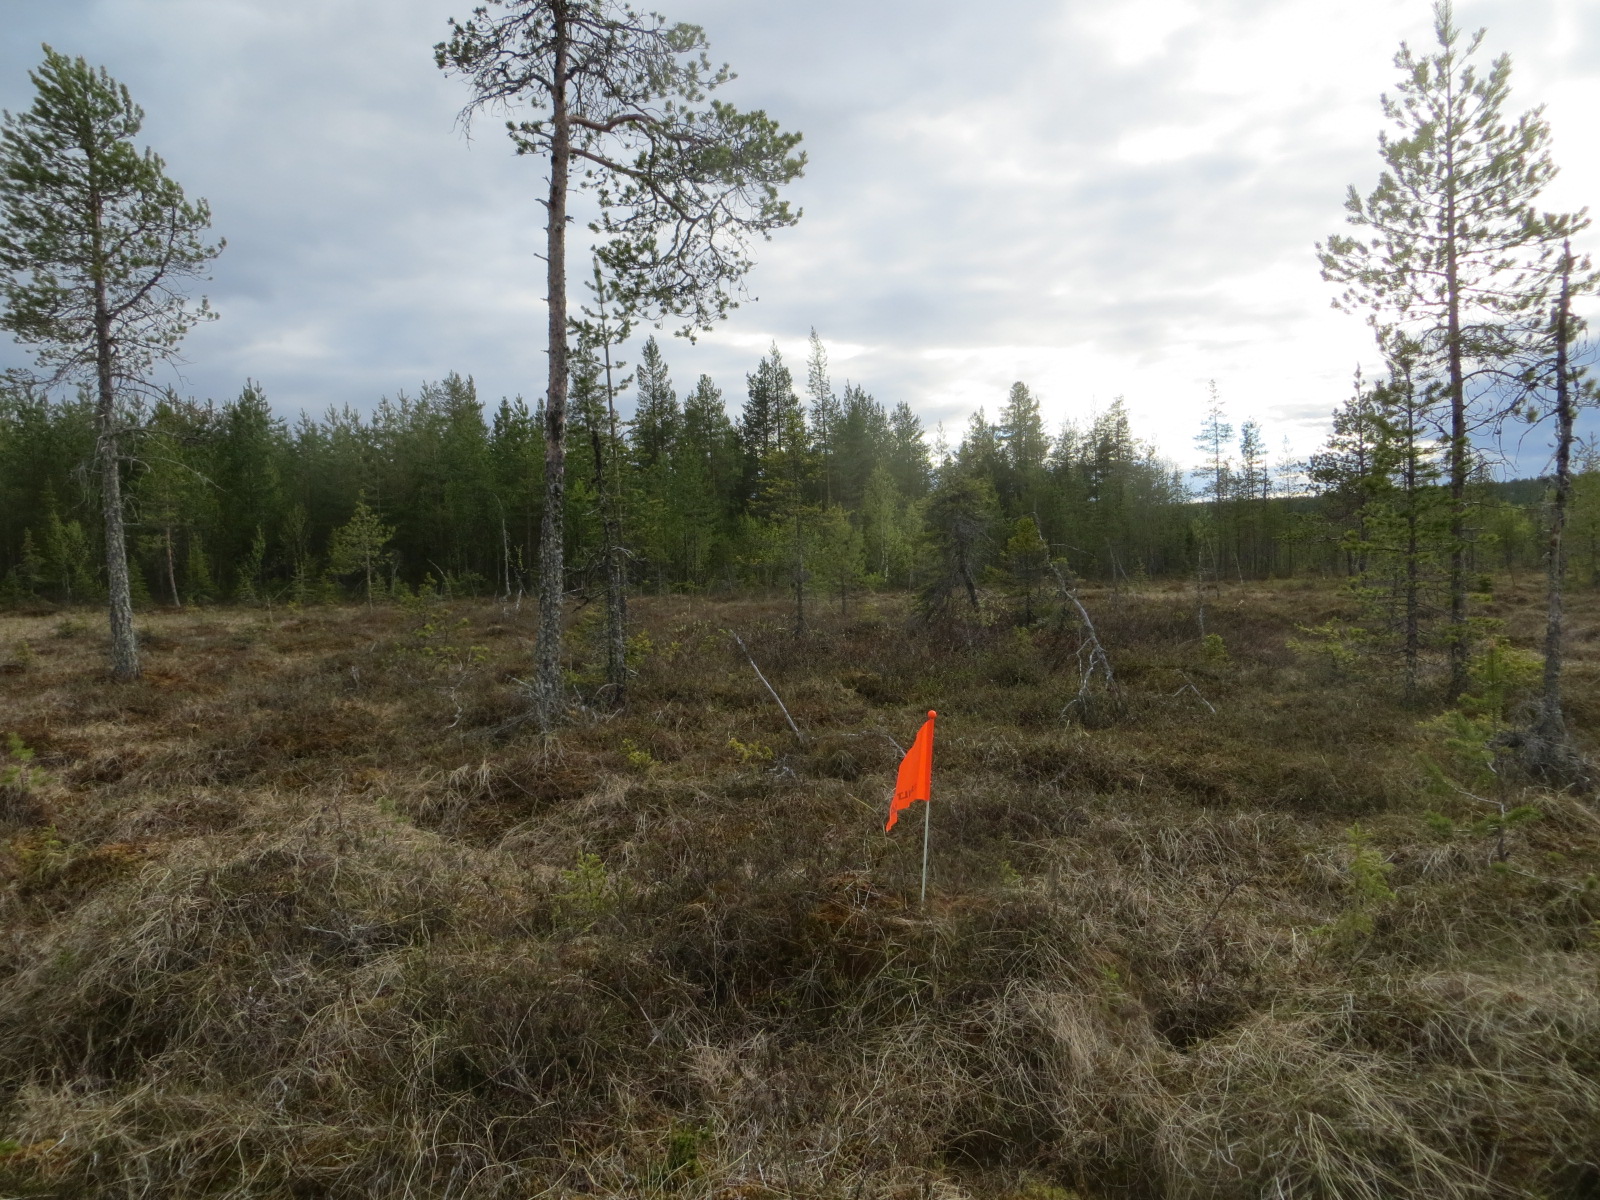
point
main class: Woodland
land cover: Pine dominated coniferous woodland
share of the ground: 25 - 50 %
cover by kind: coniferous forest trees 30 %, shrubs 30 %, herbaceous plants 30 %, lichens and mosses 10 %
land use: Semi-natural and natural areas not in use
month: June
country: FI
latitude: 67.1478
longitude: 24.8794
